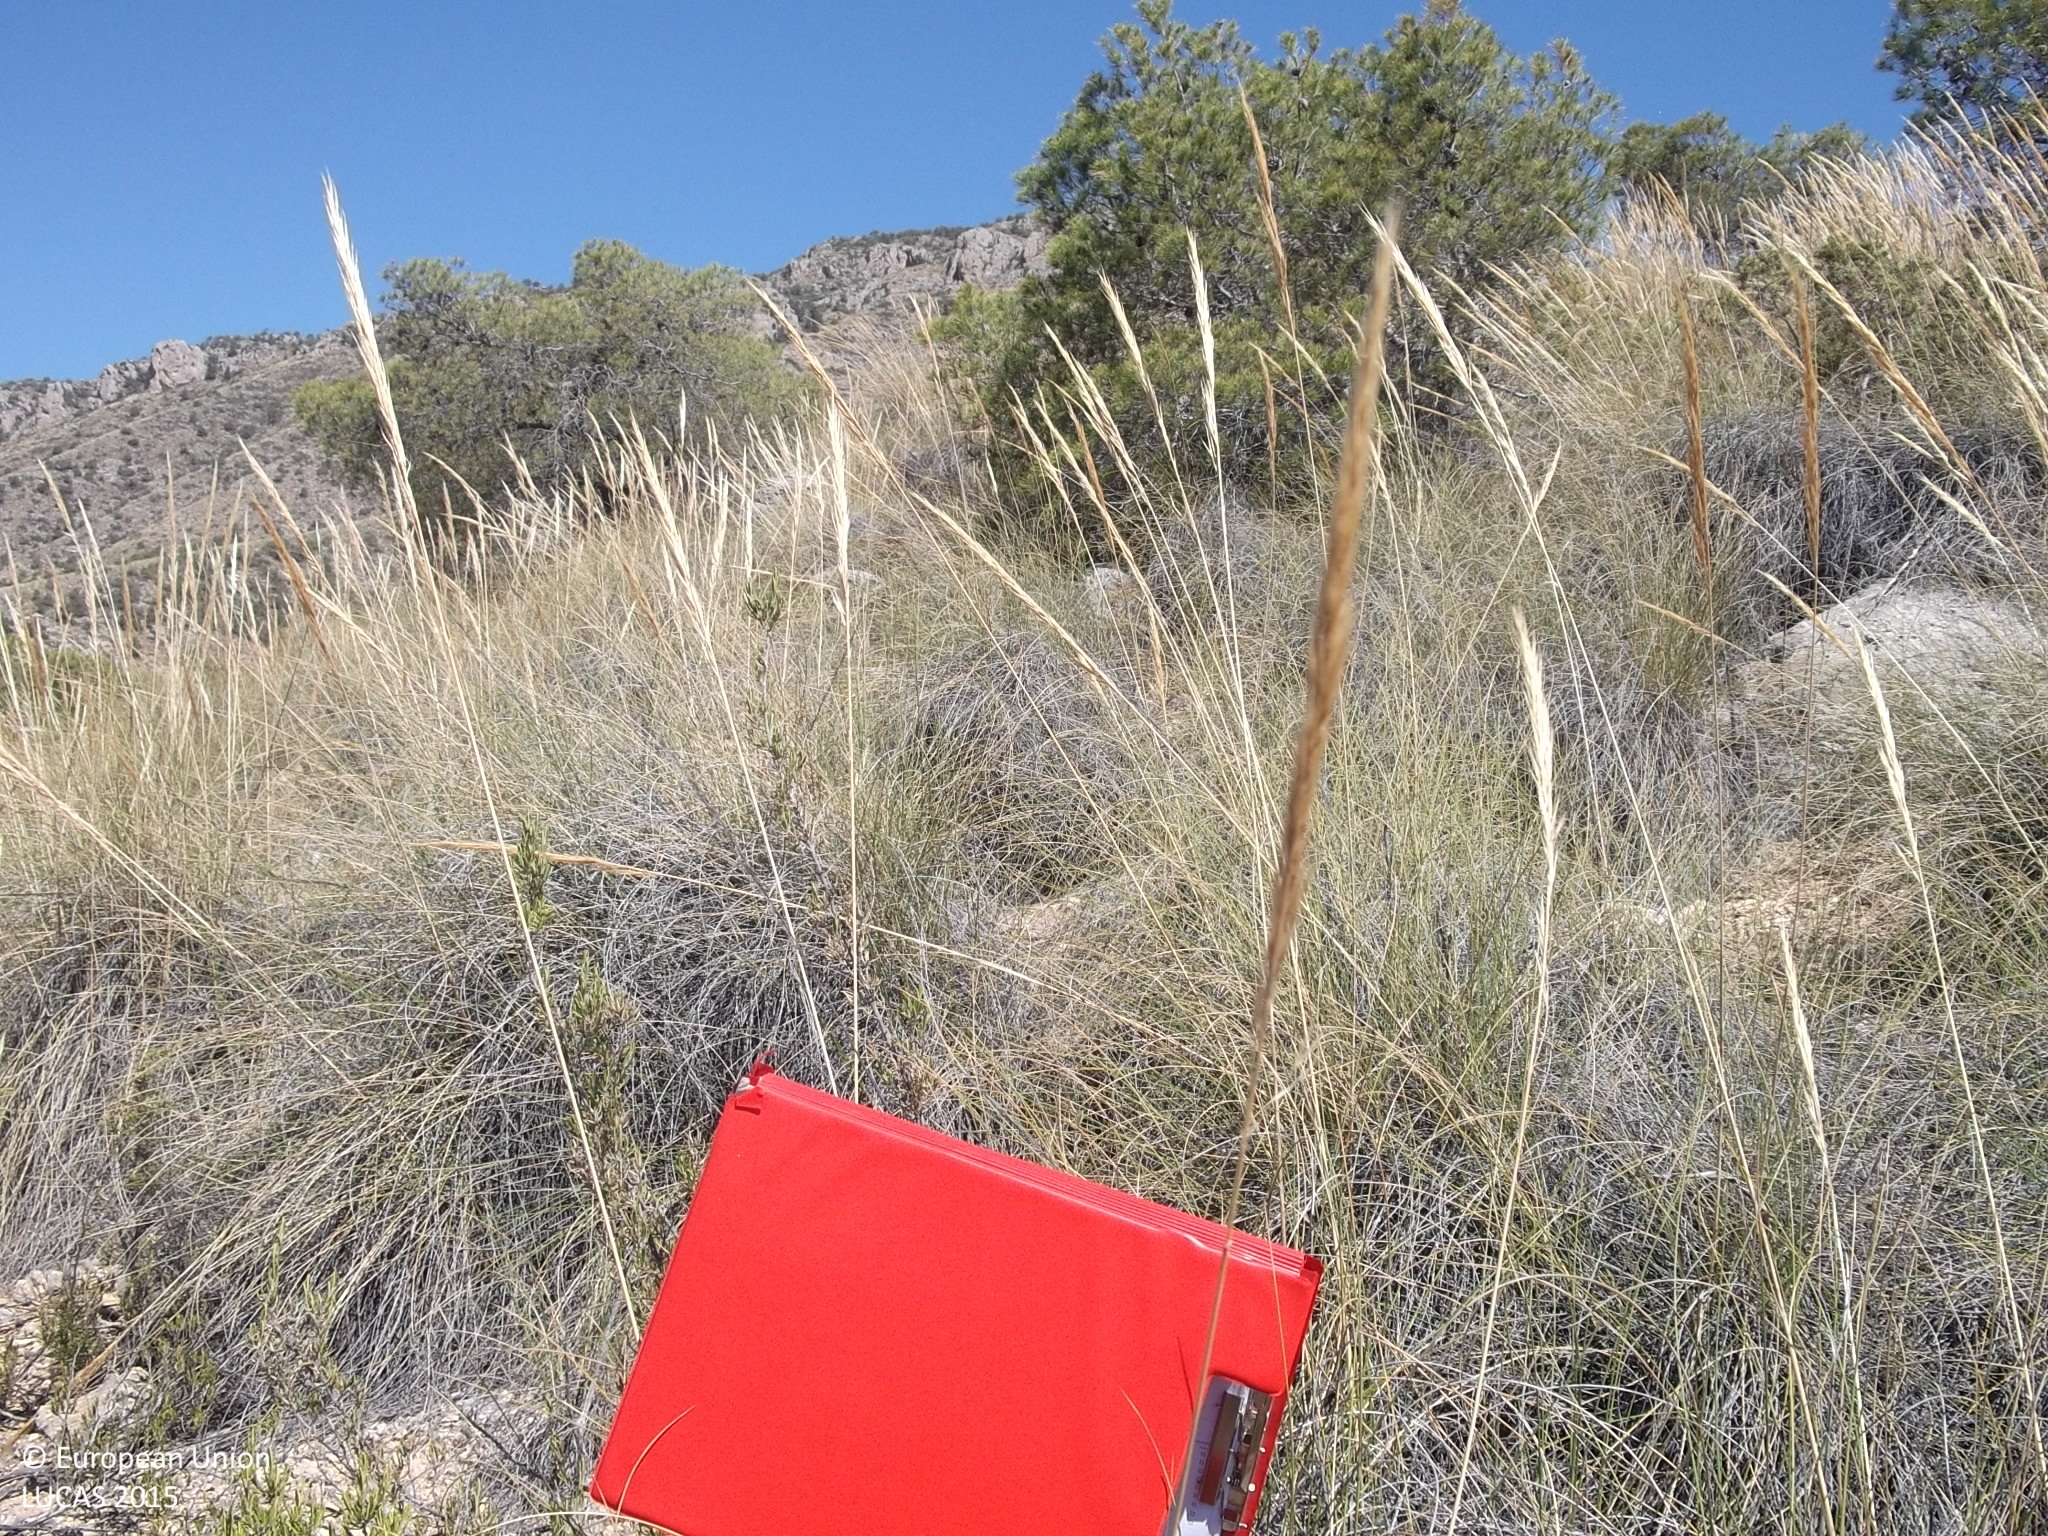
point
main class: Woodland
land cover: Pine dominated coniferous woodland
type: coniferous forest of the mediterranean region
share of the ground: 10 - 25 %
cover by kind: shrubs 30 %, herbaceous plants 30 %, coniferous forest trees 20 %, consolidated bare surface 20 %
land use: Forestry
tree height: < 5 m
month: June
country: ES
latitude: 38.1863
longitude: -1.4620
